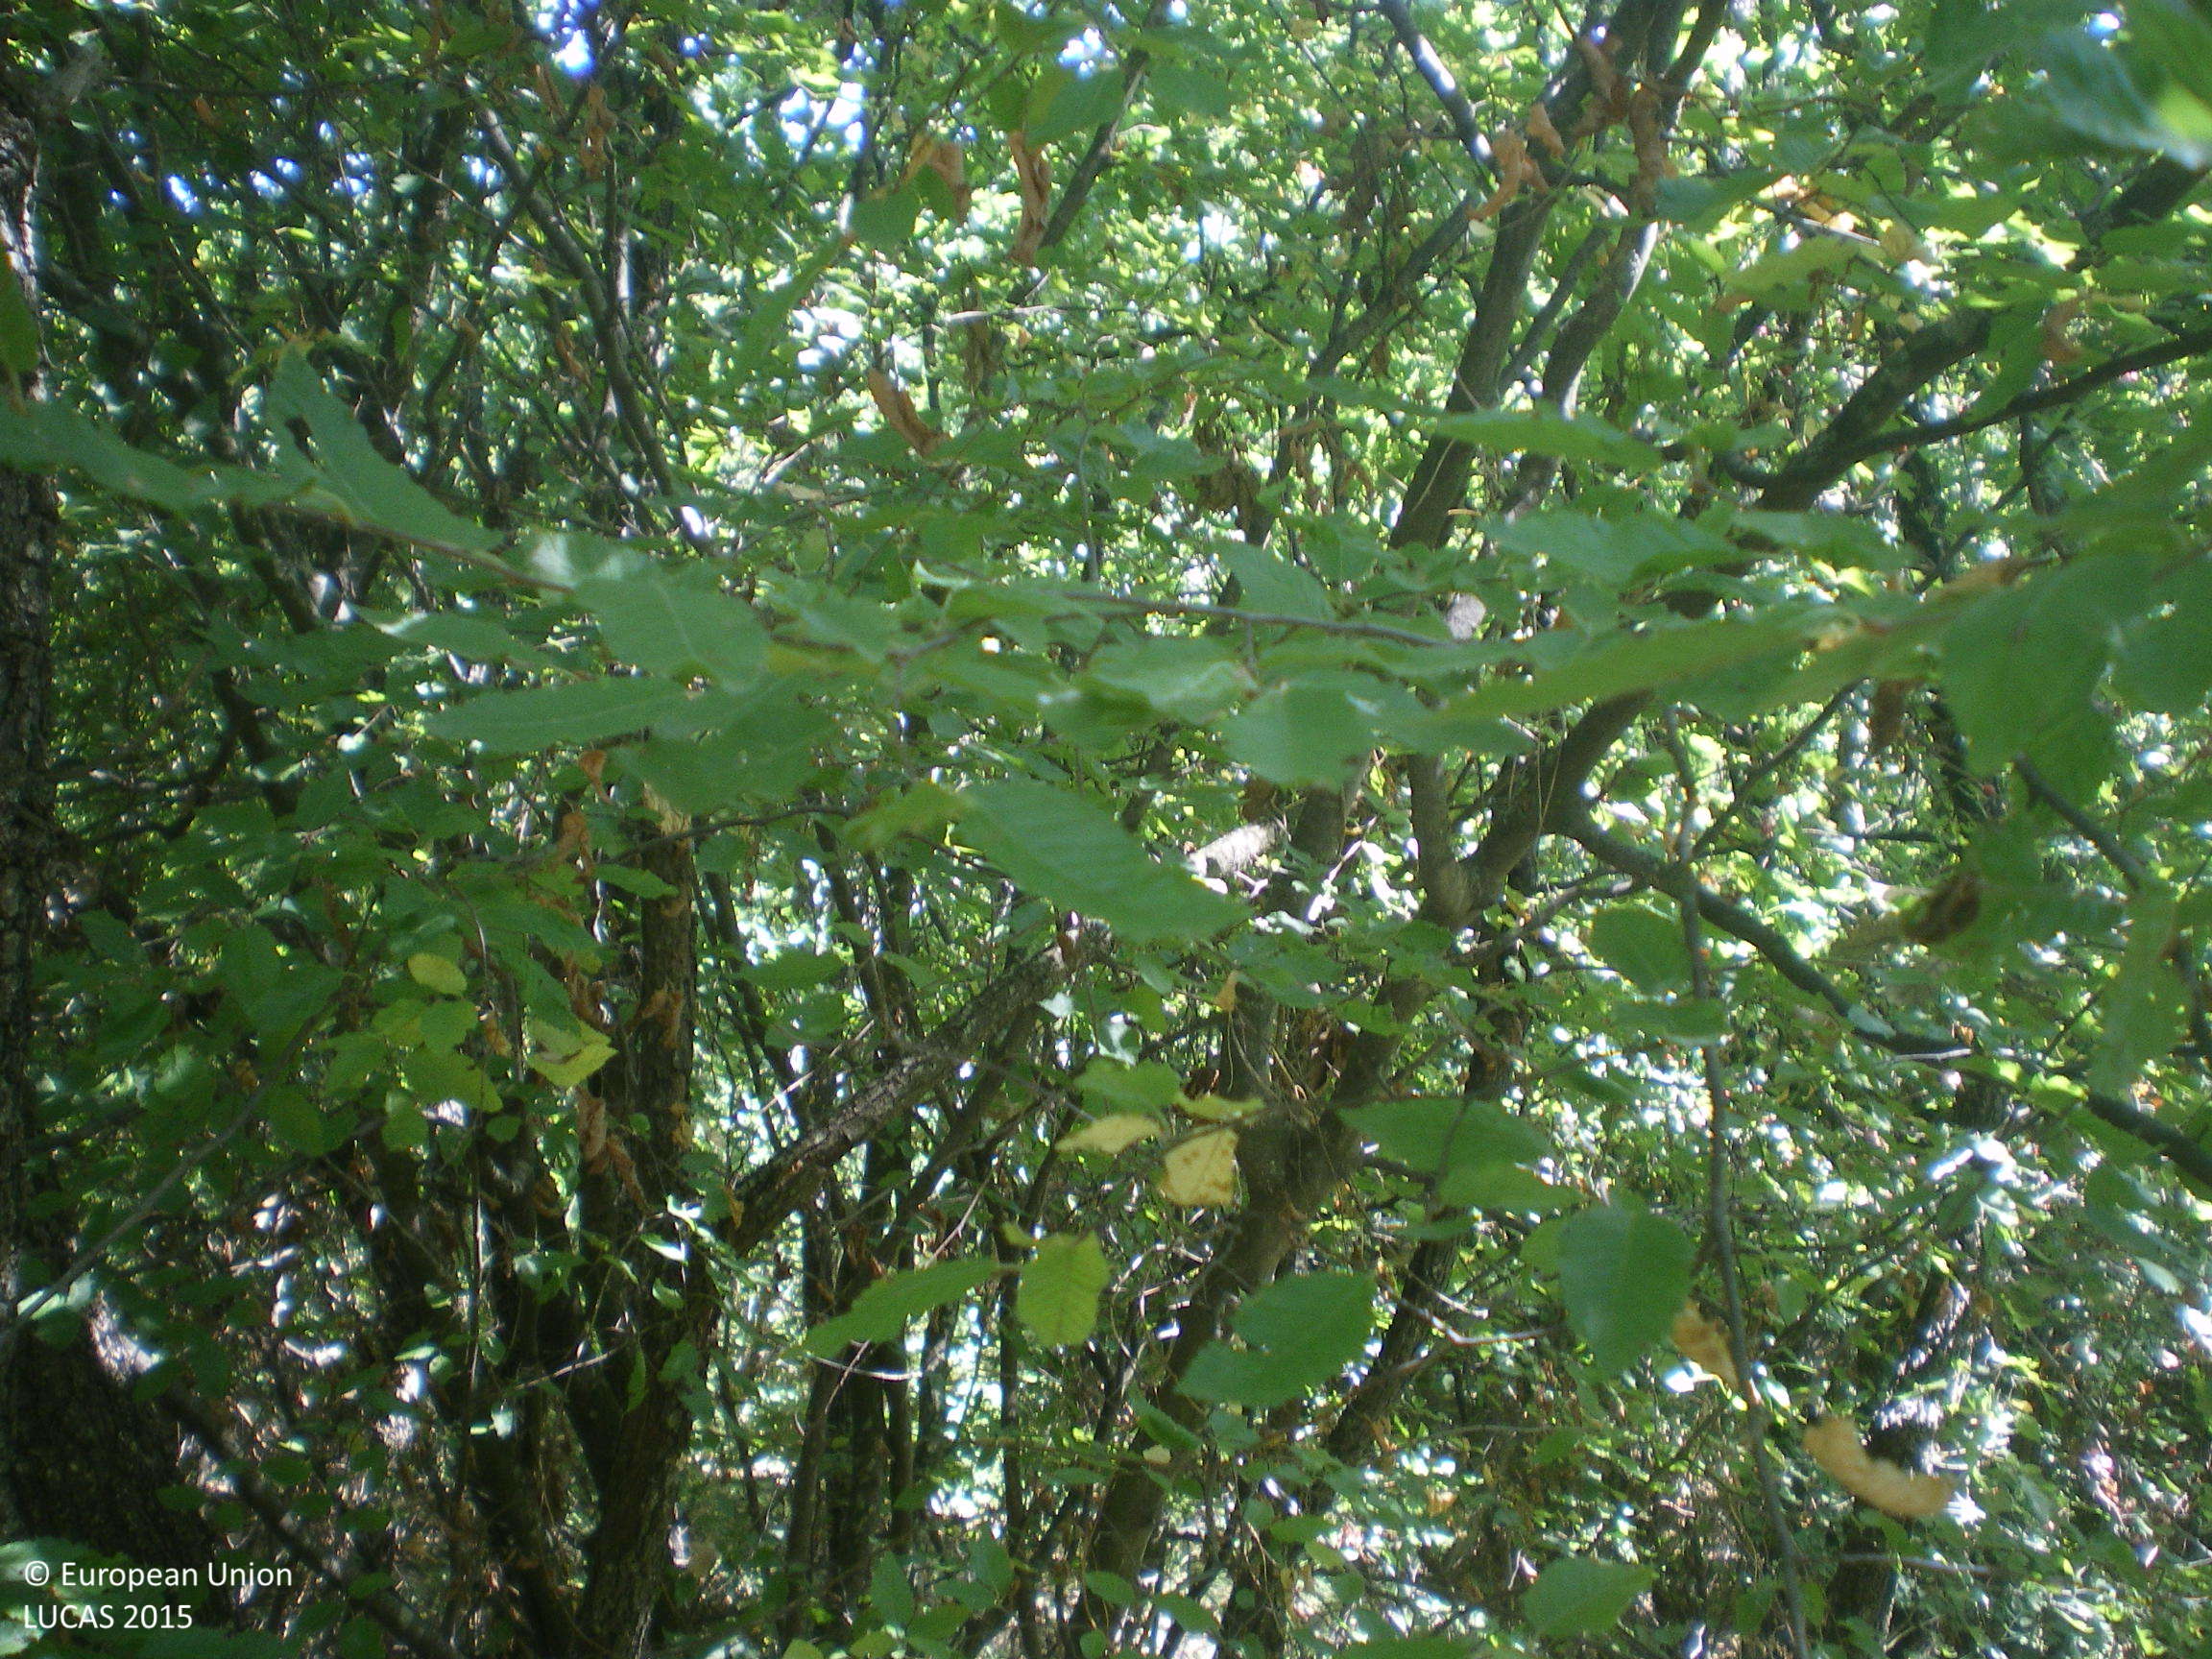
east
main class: Woodland
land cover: Broadleaved woodland
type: mesophytic deciduous forest
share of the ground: > 75 %
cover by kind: broadleaved forest trees 100 %
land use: Forestry
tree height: > 5 m
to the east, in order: Broadleaved woodland; Rivers and streams; Broadleaved woodland; Grass margins; Common wheat
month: September
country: BG
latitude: 41.7462
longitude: 26.2996
